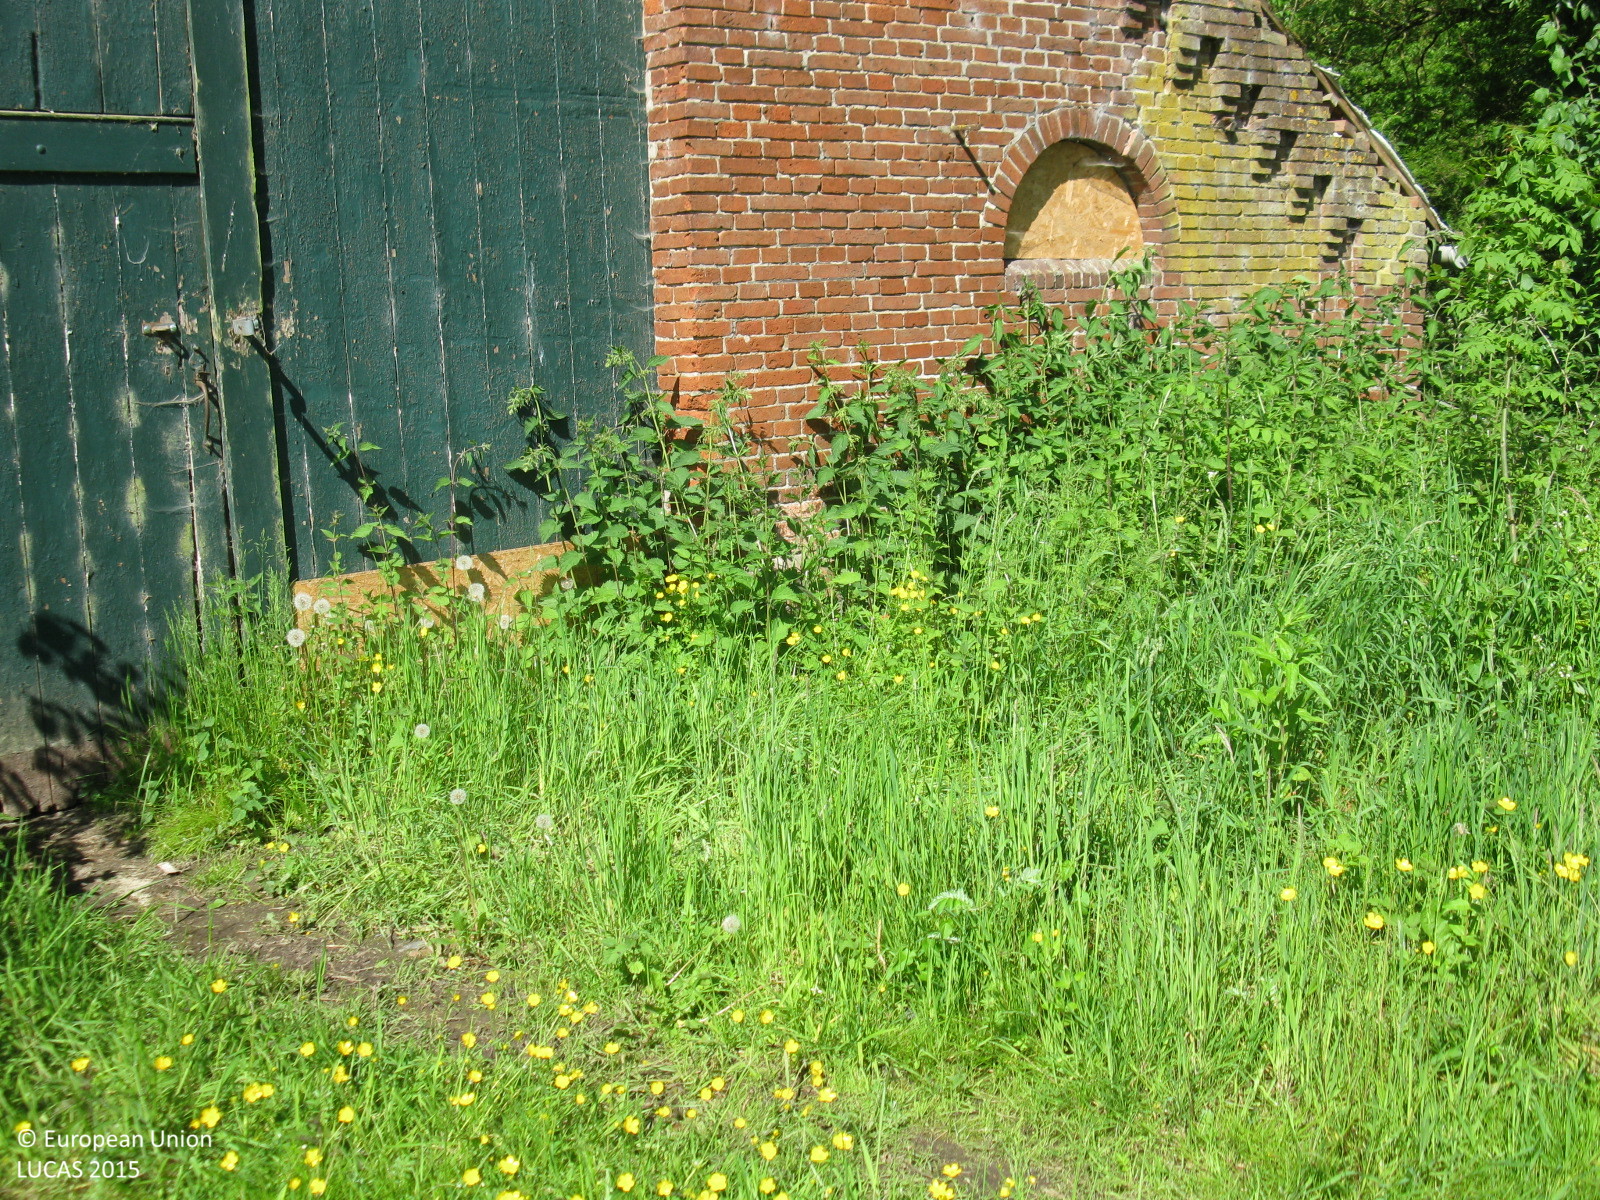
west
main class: Grassland
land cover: Grassland without tree/shrub cover
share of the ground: > 75 %
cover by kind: herbaceous plants 100 %
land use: Residential
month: June
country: DE
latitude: 53.2836
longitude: 7.3757
